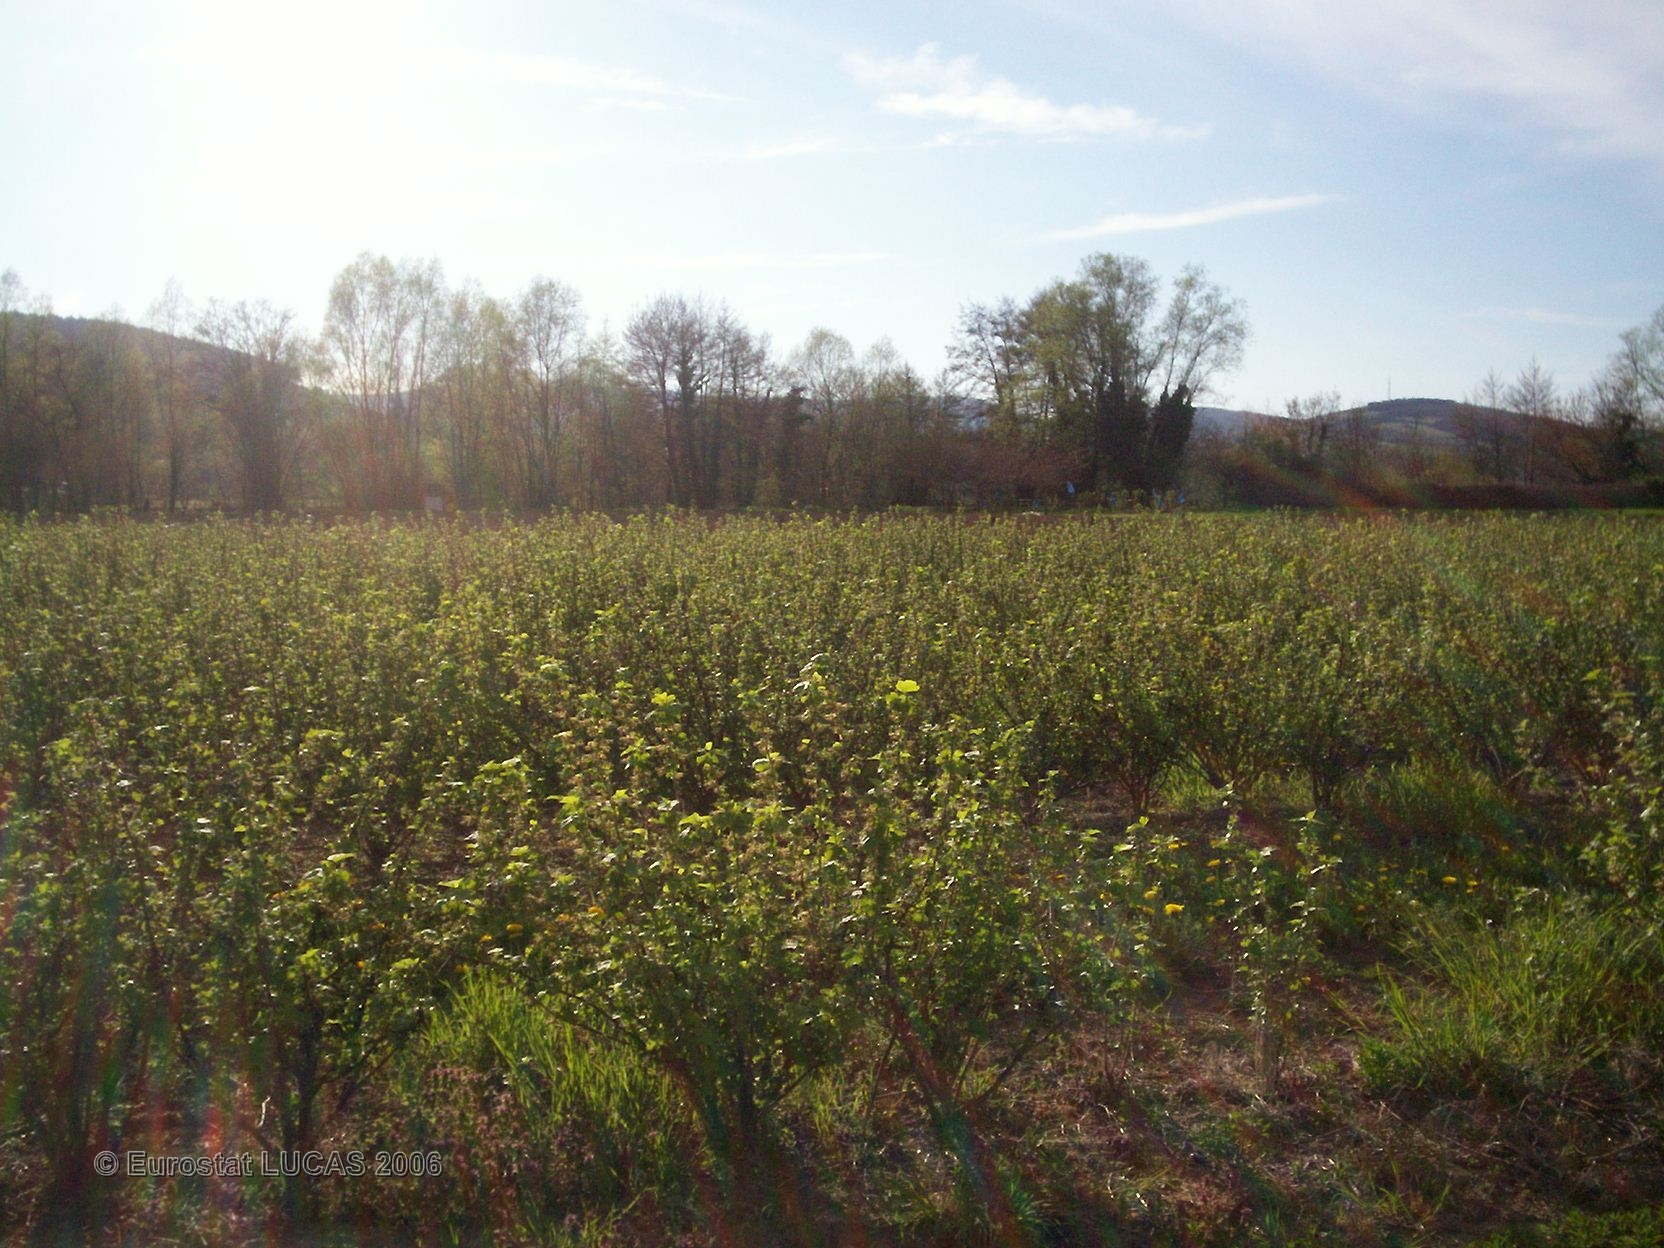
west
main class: Cropland
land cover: Other fruit trees and berries
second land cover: Grassland with sparse tree/shrub cover
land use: Agriculture (excluding fallow land and kitchen gardens)
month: April
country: FR
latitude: 46.3302
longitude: 4.7412
